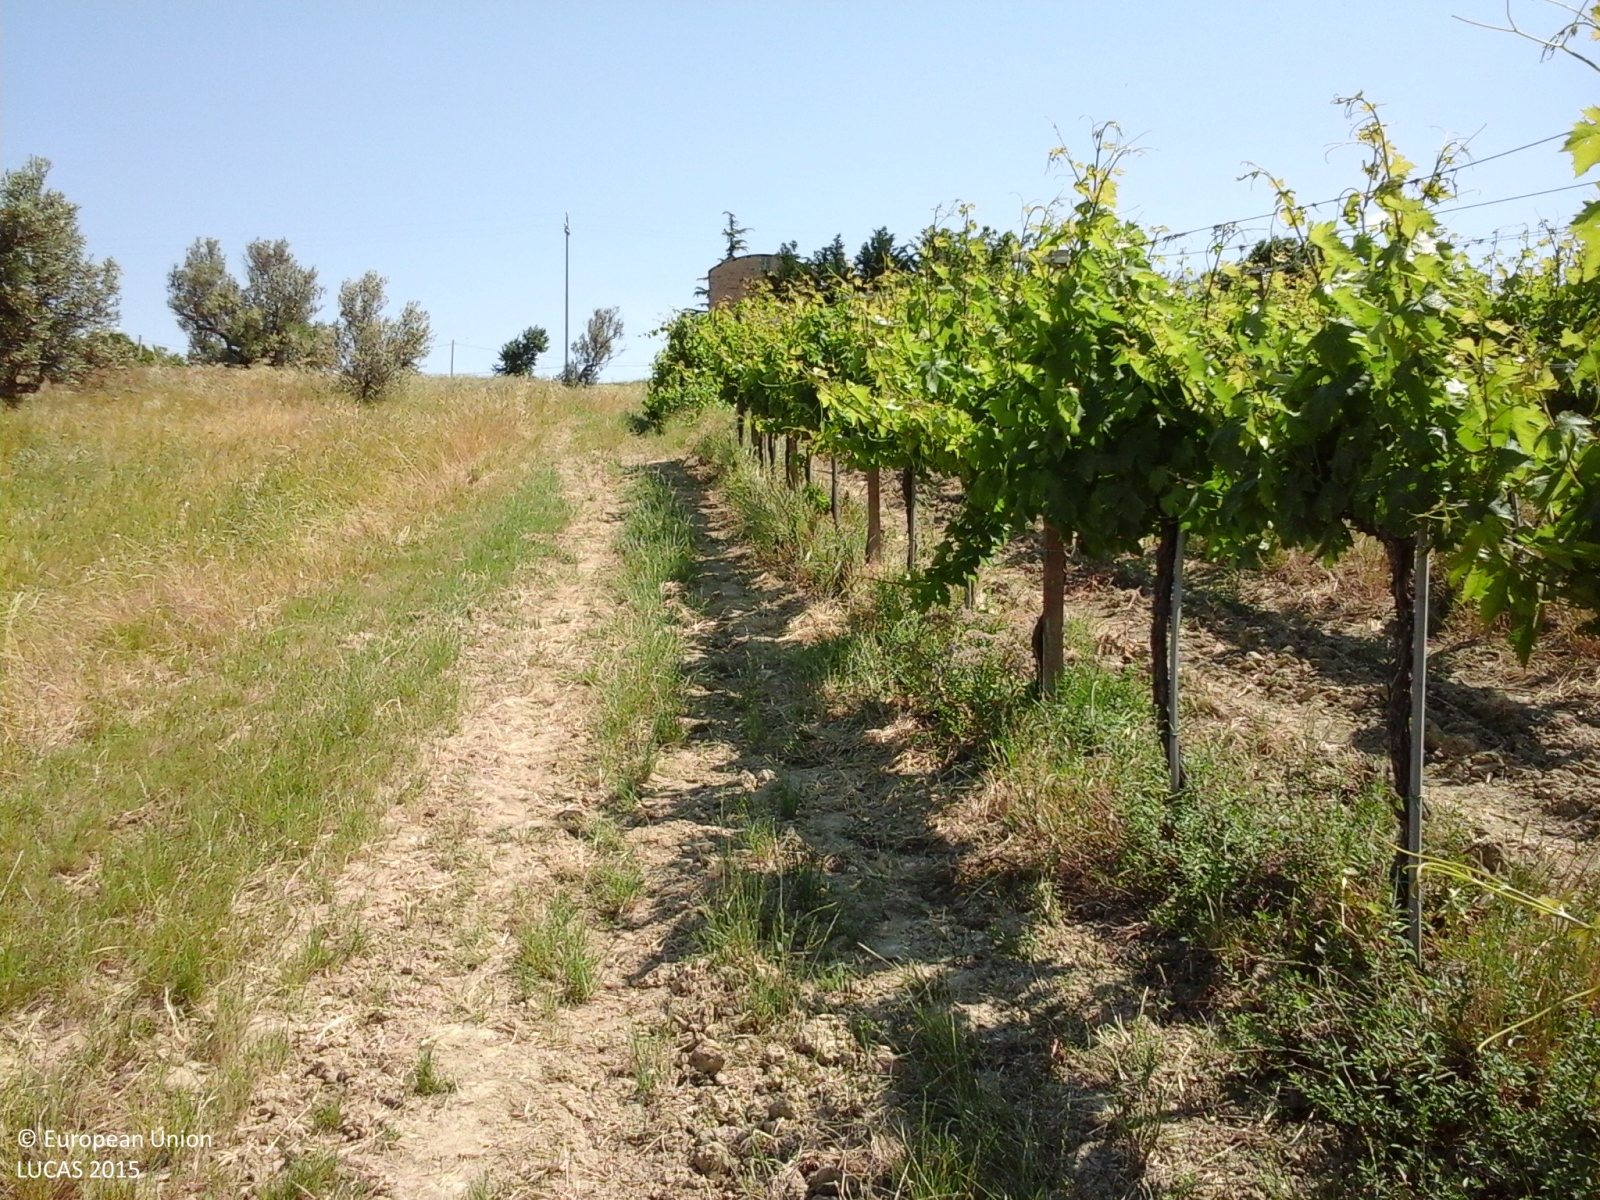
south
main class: Cropland
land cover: Vineyards
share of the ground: > 75 %
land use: Agriculture (excluding fallow land and kitchen gardens)
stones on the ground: < 10 %
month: May
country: IT
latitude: 42.1380
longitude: 14.4990
